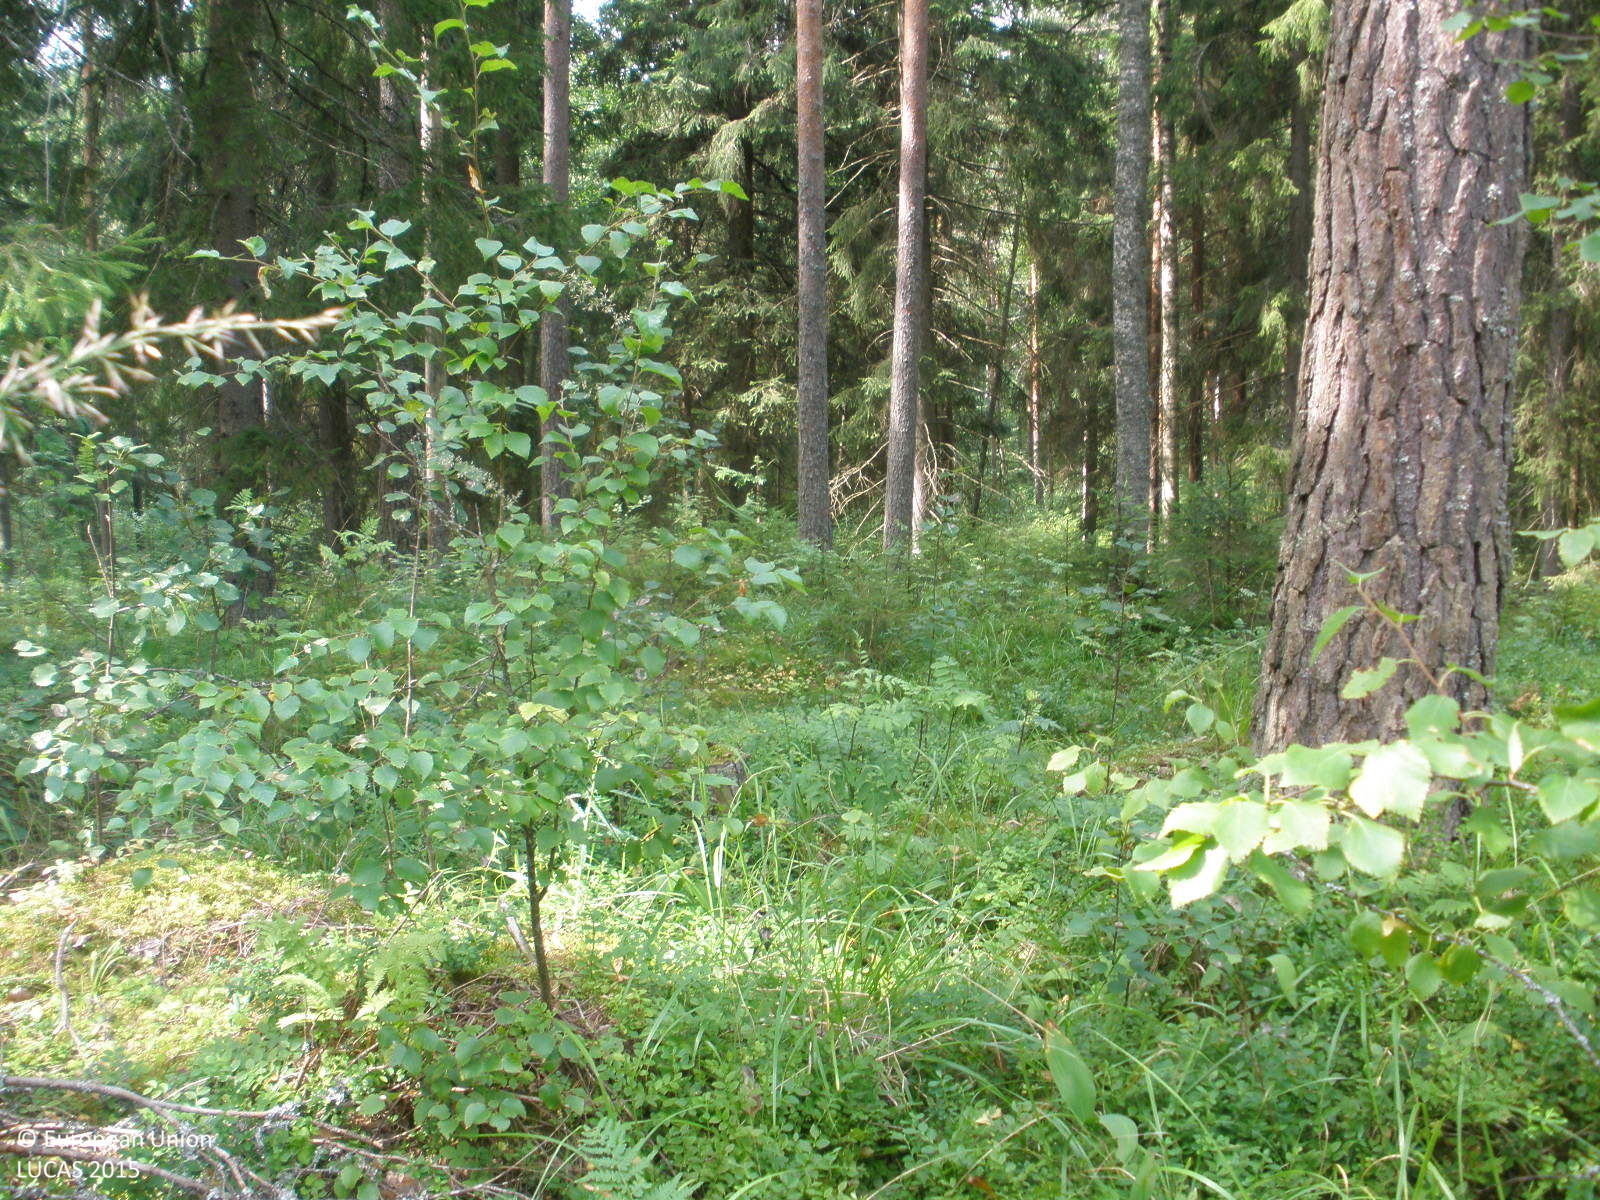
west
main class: Woodland
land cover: Other coniferous woodland
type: boreal forest
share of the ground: > 75 %
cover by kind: coniferous forest trees 85 %, herbaceous plants 10 %, lichens and mosses 5 %
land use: Forestry
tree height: > 5 m
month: August
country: FI
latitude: 60.8244
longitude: 24.4653
